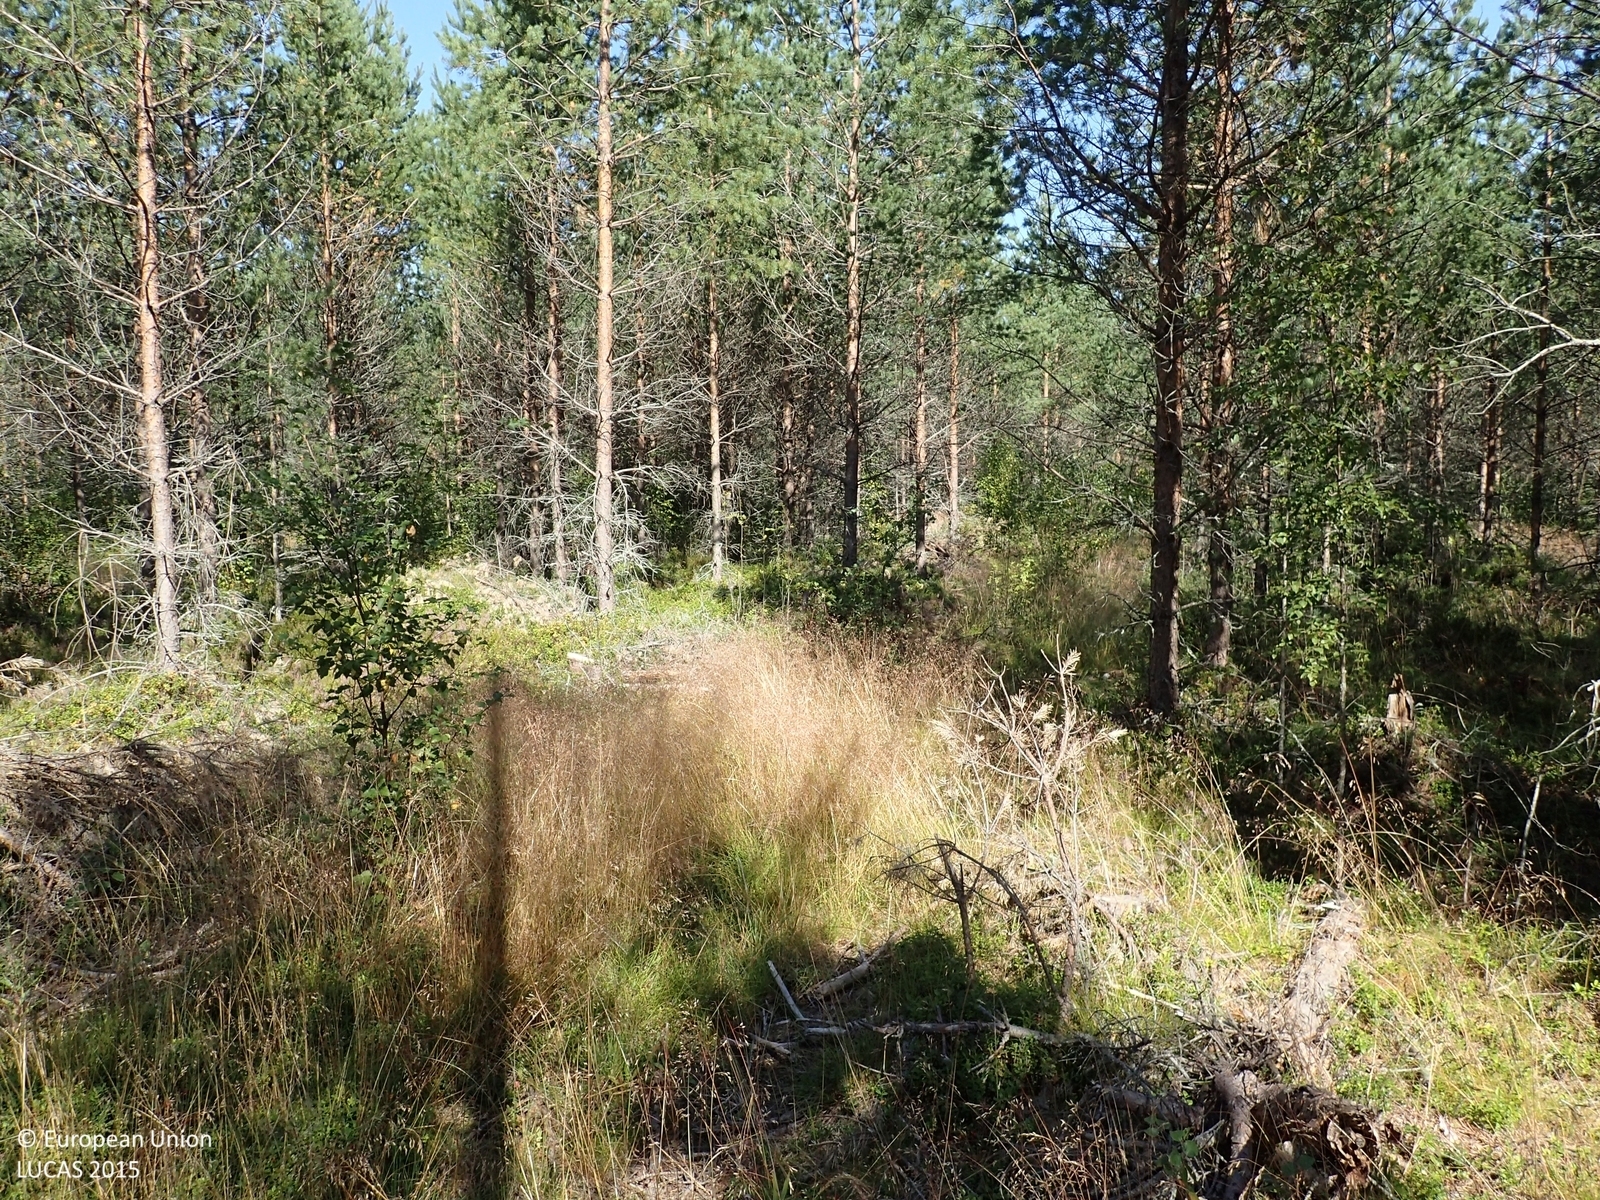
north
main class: Woodland
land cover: Pine dominated coniferous woodland
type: boreal forest
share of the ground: > 75 %
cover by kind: coniferous forest trees 75 %, shrubs 15 %, broadleaved forest trees 5 %, herbaceous plants 5 %
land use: Forestry
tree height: < 5 m
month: August
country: FI
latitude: 62.5331
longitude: 21.7648
